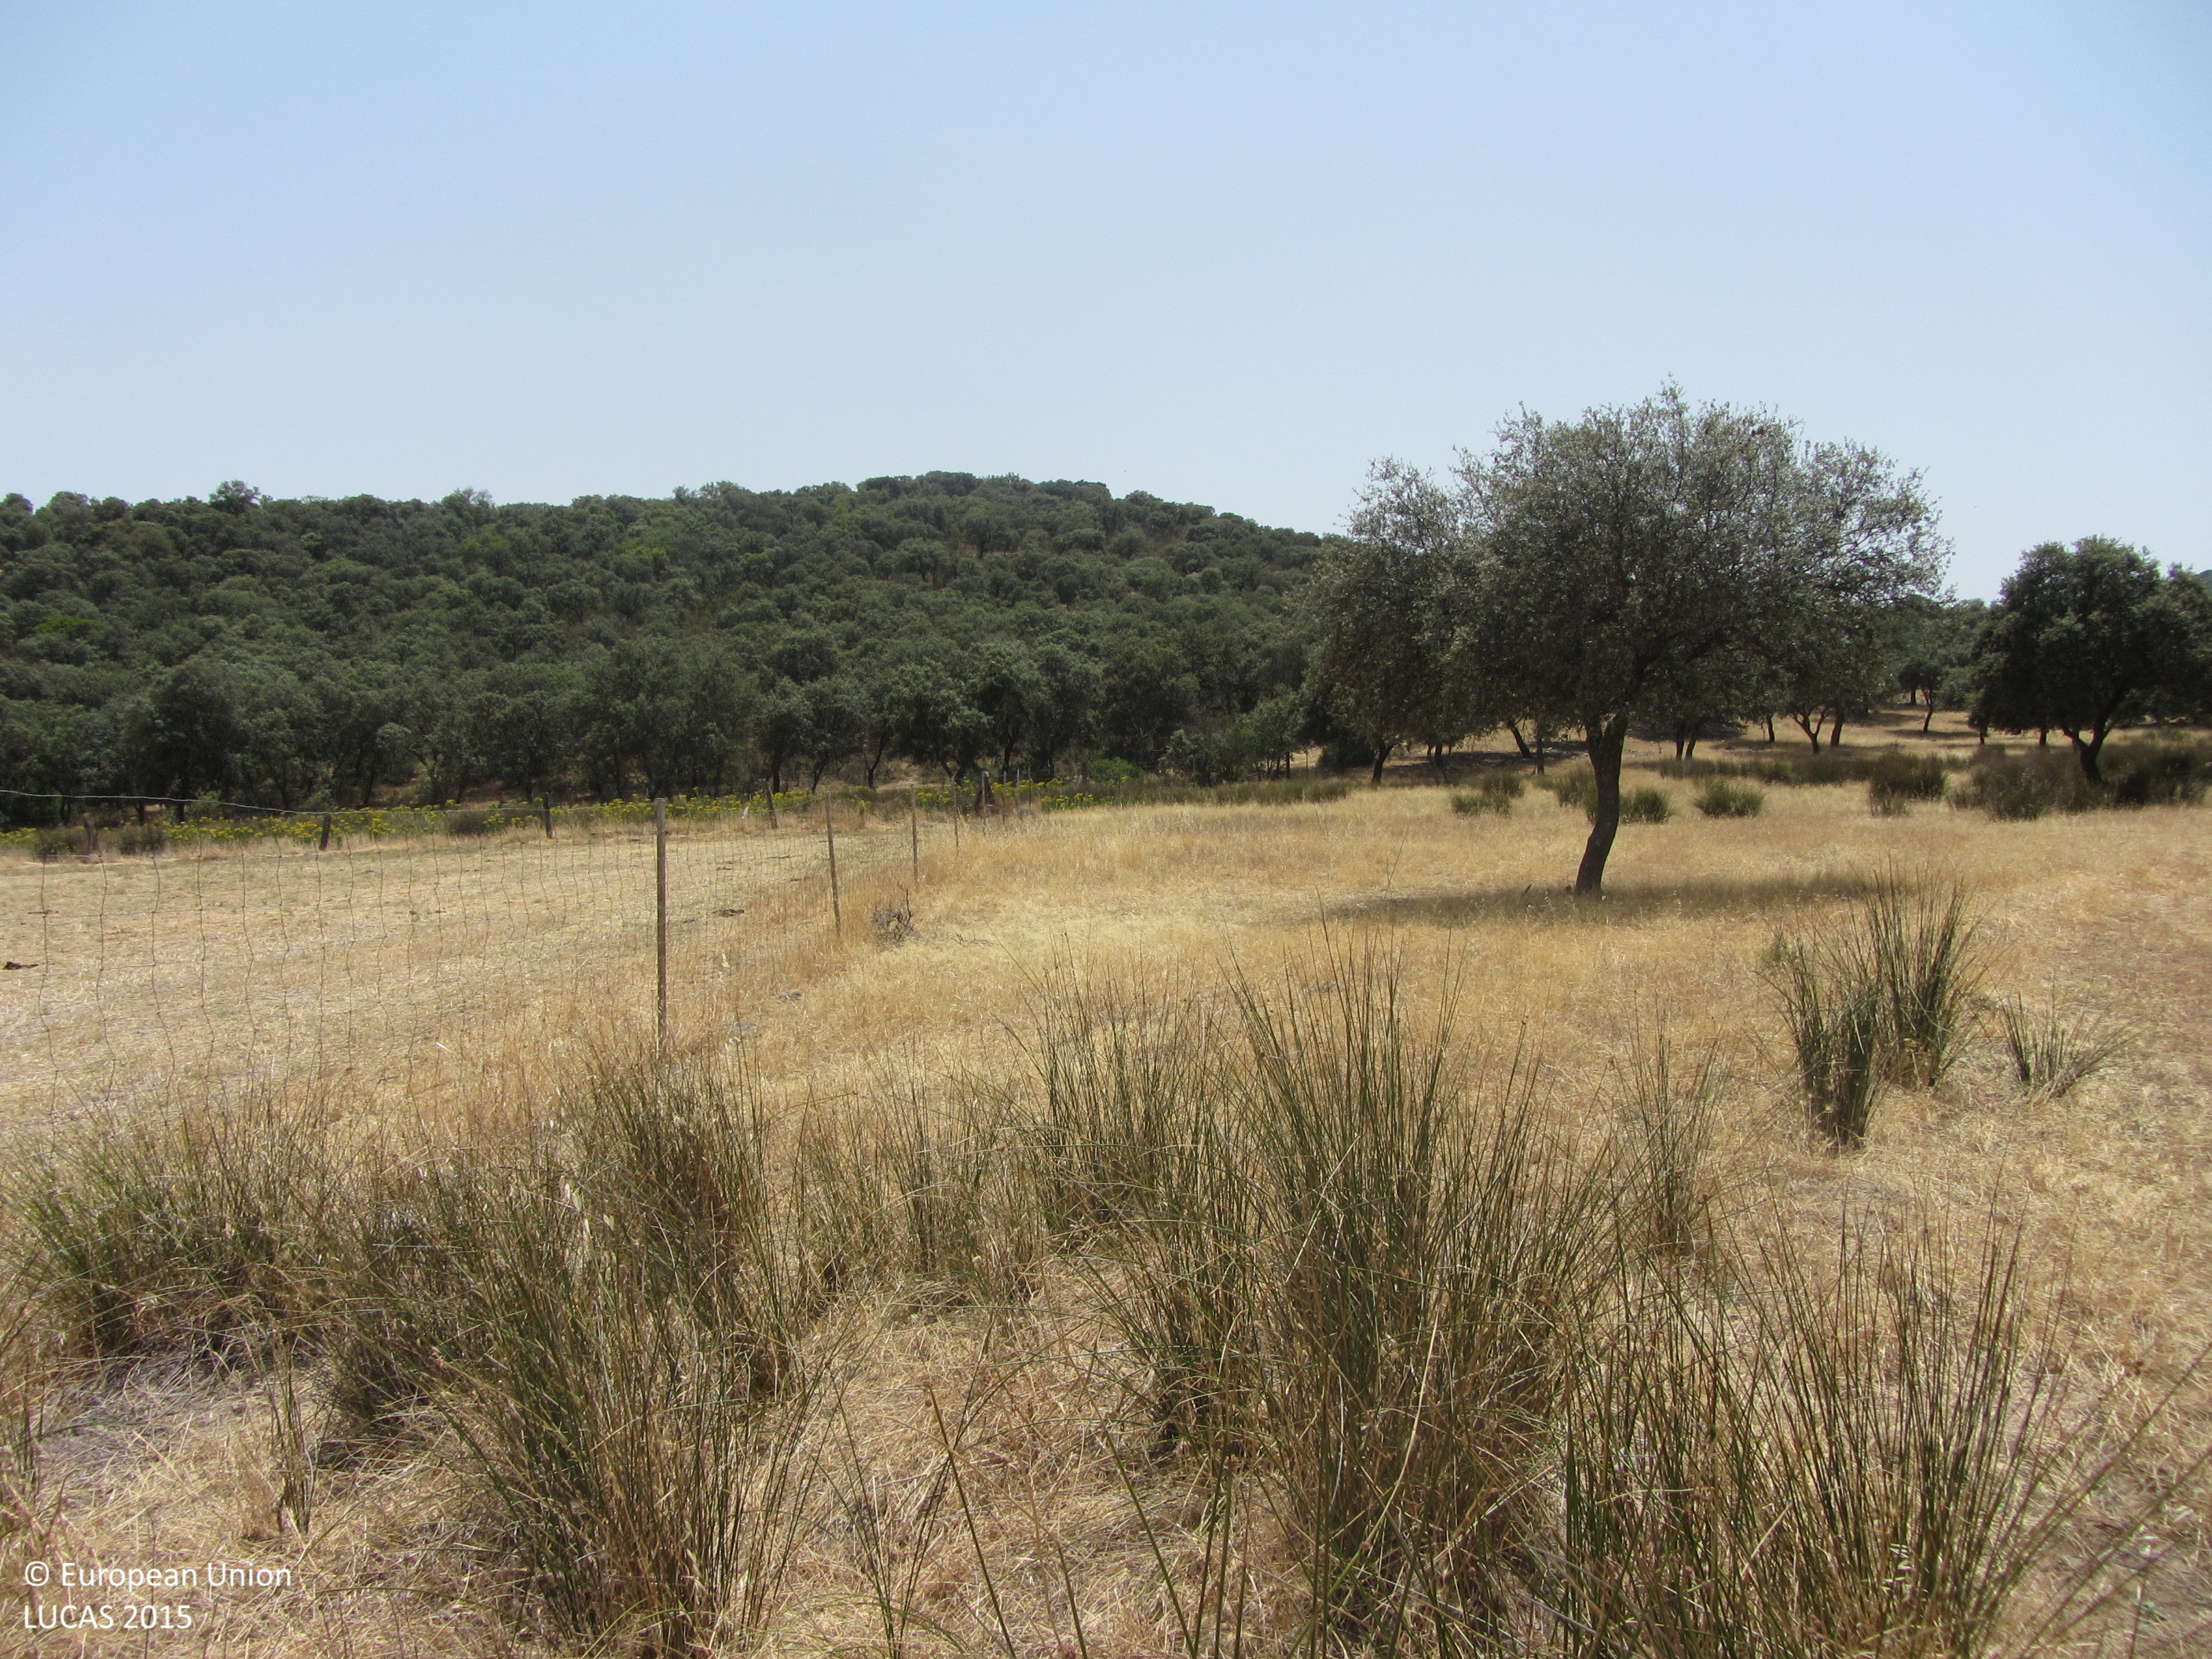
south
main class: Woodland
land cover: Broadleaved woodland
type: broadleaved evergreen forest
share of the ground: 25 - 50 %
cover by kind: herbaceous plants 40 %, broadleaved forest trees 35 %, shrubs 25 %
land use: Other primary production
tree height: > 5 m
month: July
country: ES
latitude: 38.1575
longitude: -3.8736
